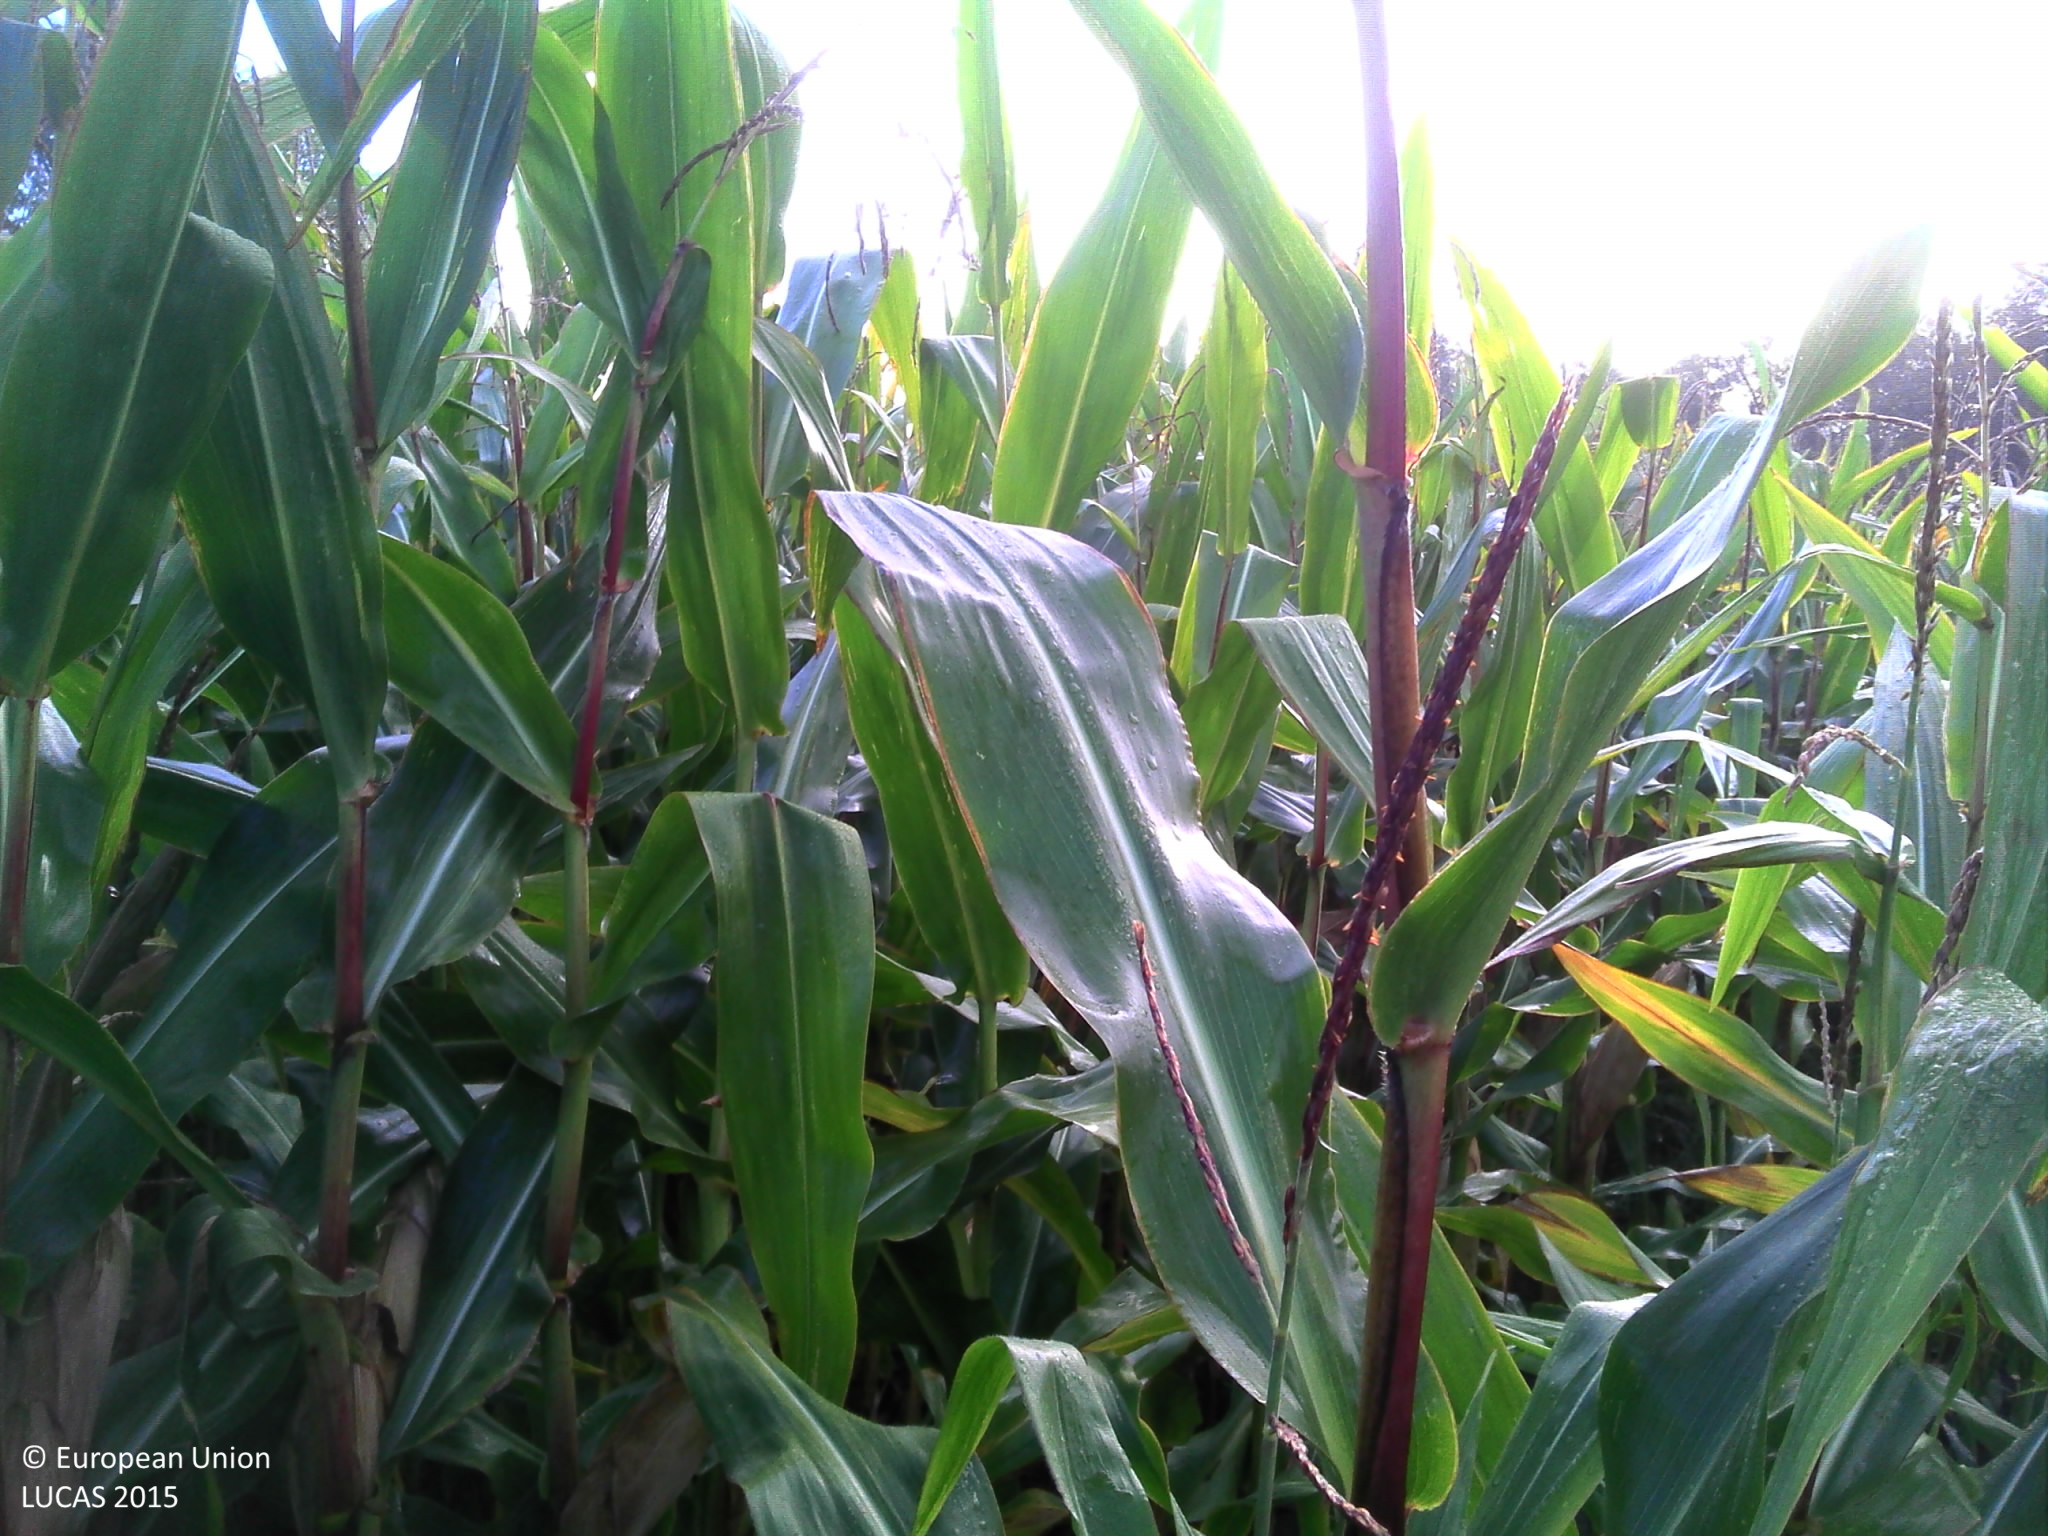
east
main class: Cropland
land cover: Maize
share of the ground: > 75 %
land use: Agriculture (excluding fallow land and kitchen gardens)
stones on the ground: < 10 %
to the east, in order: Maize; Single bushes/trees; Tracks; Grassland without tree/shrub cover; Tracks; Grass margins; Paved roads, cycling and walking lanes; Grassland without tree/shrub cover; Spontaneously vegetated surfaces; Broadleaved woodland; Inland fresh running water
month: September
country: BE
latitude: 51.0747
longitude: 4.4149
